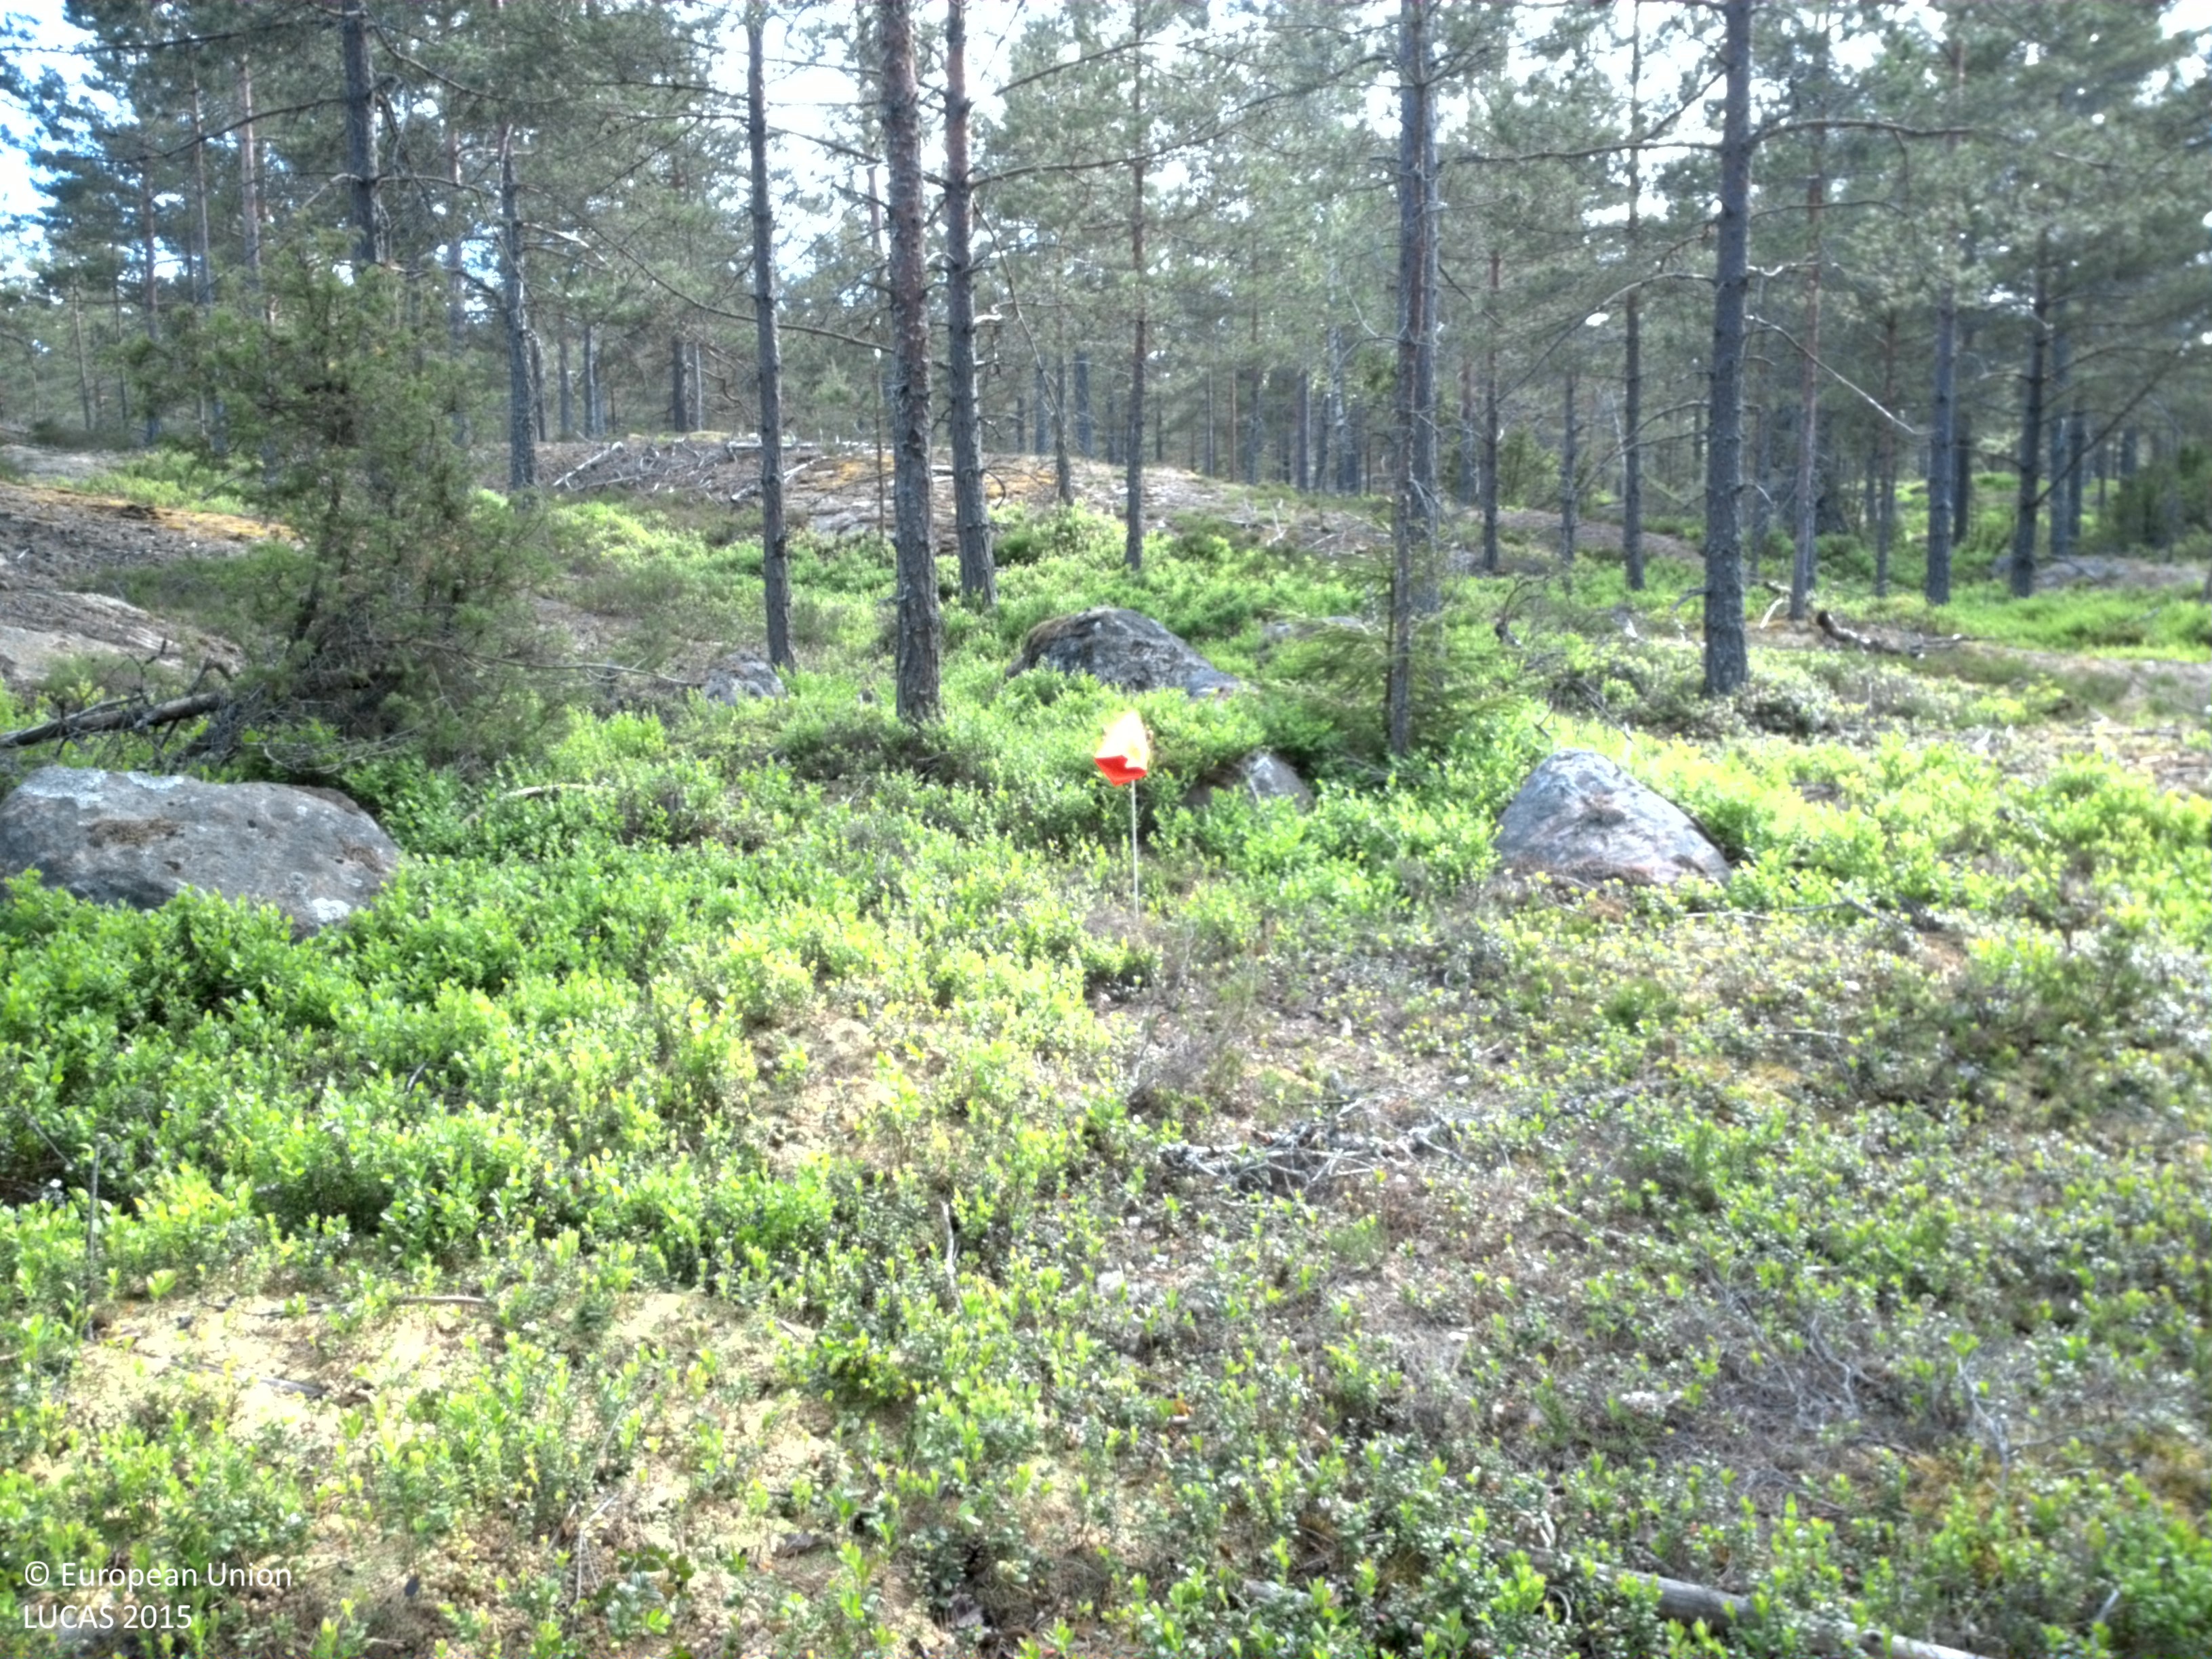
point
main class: Woodland
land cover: Pine dominated coniferous woodland
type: boreal forest
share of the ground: 10 - 25 %
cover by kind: lichens and mosses 35 %, shrubs 25 %, coniferous forest trees 20 %, unconsolidated bare surface 20 %
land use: Forestry
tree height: > 5 m
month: June
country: SE
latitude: 58.7186
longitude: 16.3664
